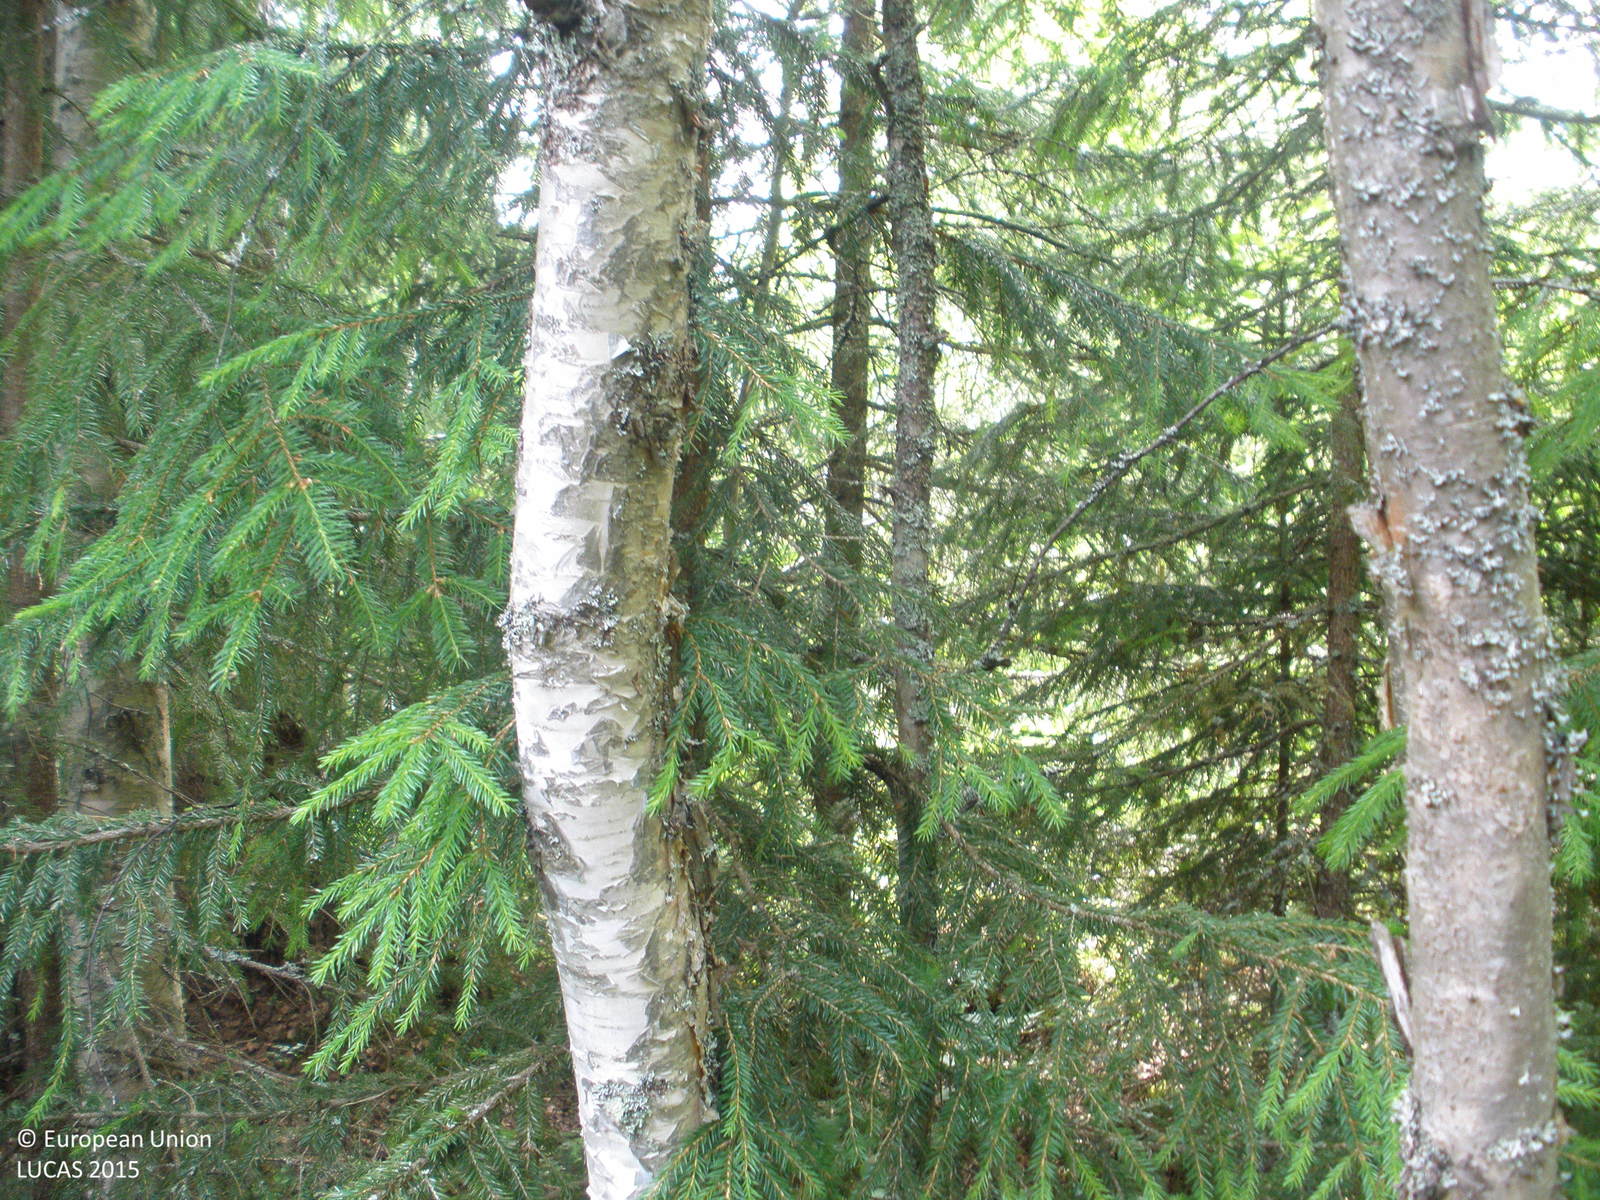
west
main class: Woodland
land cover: Spruce dominated mixed woodland
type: boreal forest
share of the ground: > 75 %
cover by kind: coniferous forest trees 55 %, broadleaved forest trees 25 %, herbaceous plants 10 %, lichens and mosses 10 %
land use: Forestry
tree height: > 5 m
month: June
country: FI
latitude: 61.1080
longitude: 24.7460
